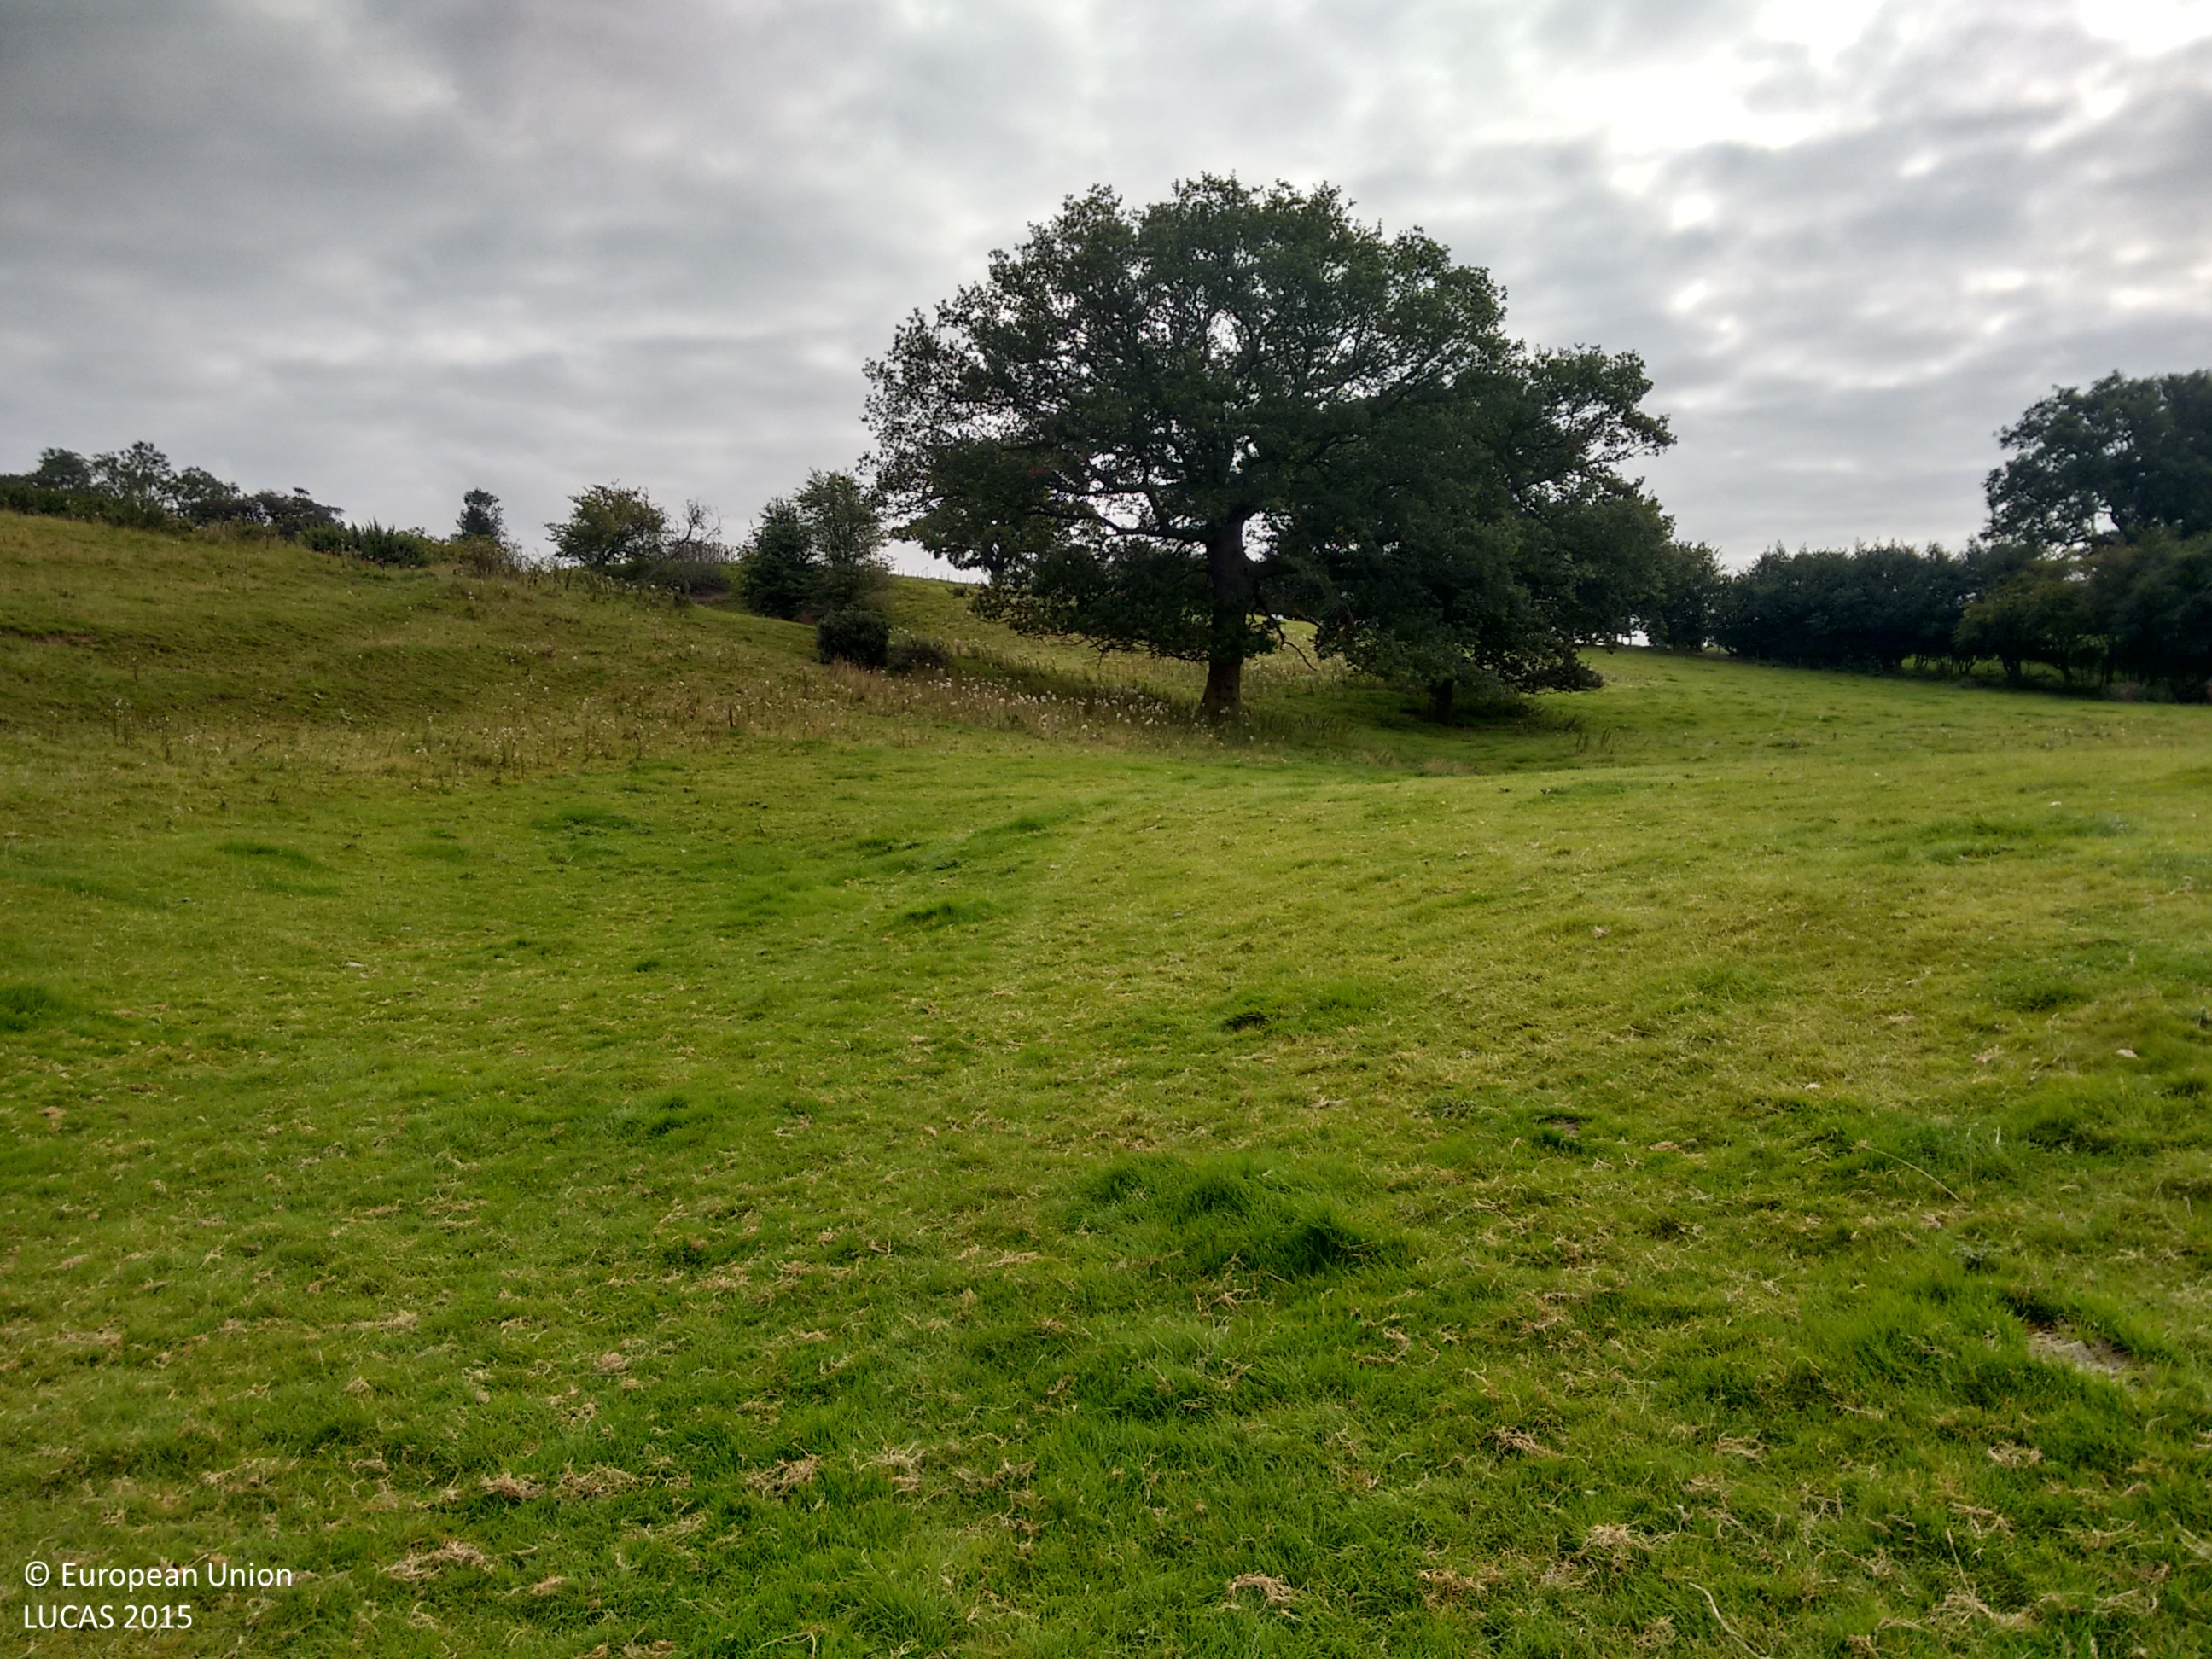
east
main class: Grassland
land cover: Grassland without tree/shrub cover
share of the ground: > 75 %
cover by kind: herbaceous plants 100 %
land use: Agriculture (excluding fallow land and kitchen gardens)
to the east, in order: Grassland without tree/shrub cover; Single bushes/trees; Grassland without tree/shrub cover; Managed hedges; Grassland without tree/shrub cover
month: September
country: GB
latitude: 52.8728
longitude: -2.8944
